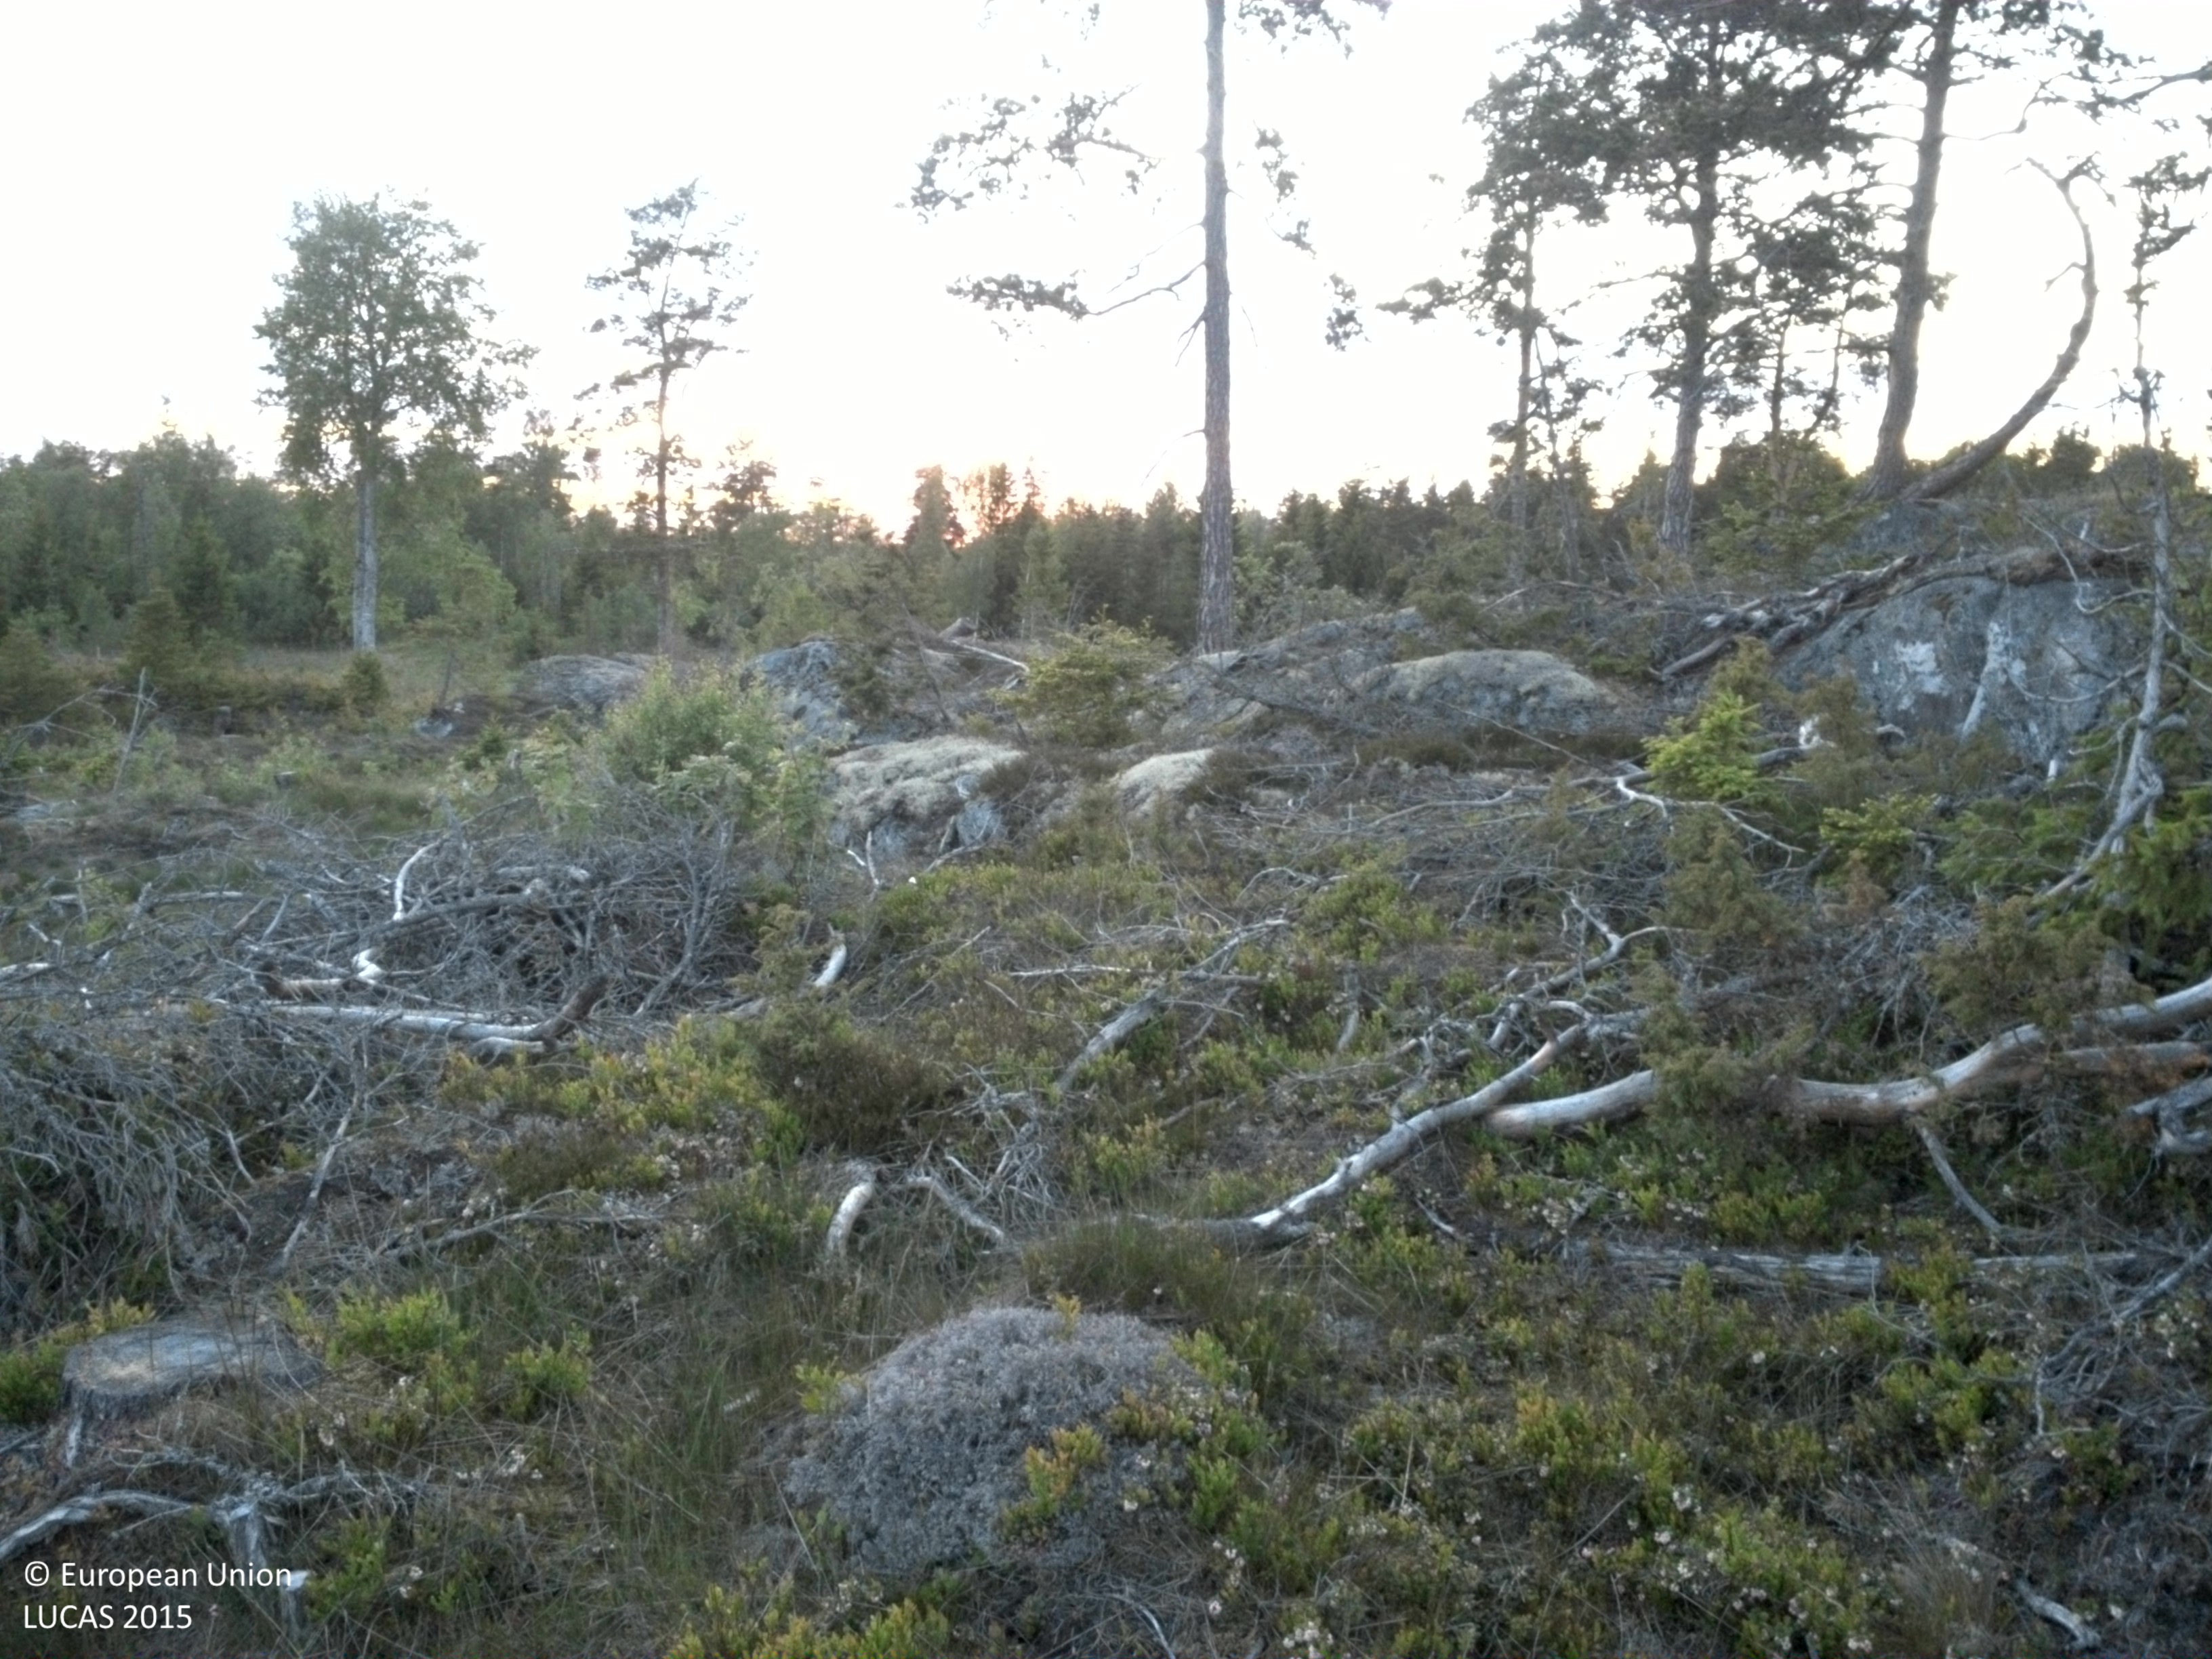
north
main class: Shrubland
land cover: Shrubland with sparse tree cover
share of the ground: 25 - 50 %
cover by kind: shrubs 35 %, consolidated bare surface 30 %, herbaceous plants 20 %, lichens and mosses 10 %, coniferous forest trees 5 %
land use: Forestry
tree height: > 5 m
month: June
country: SE
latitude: 60.0516
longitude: 18.7805
